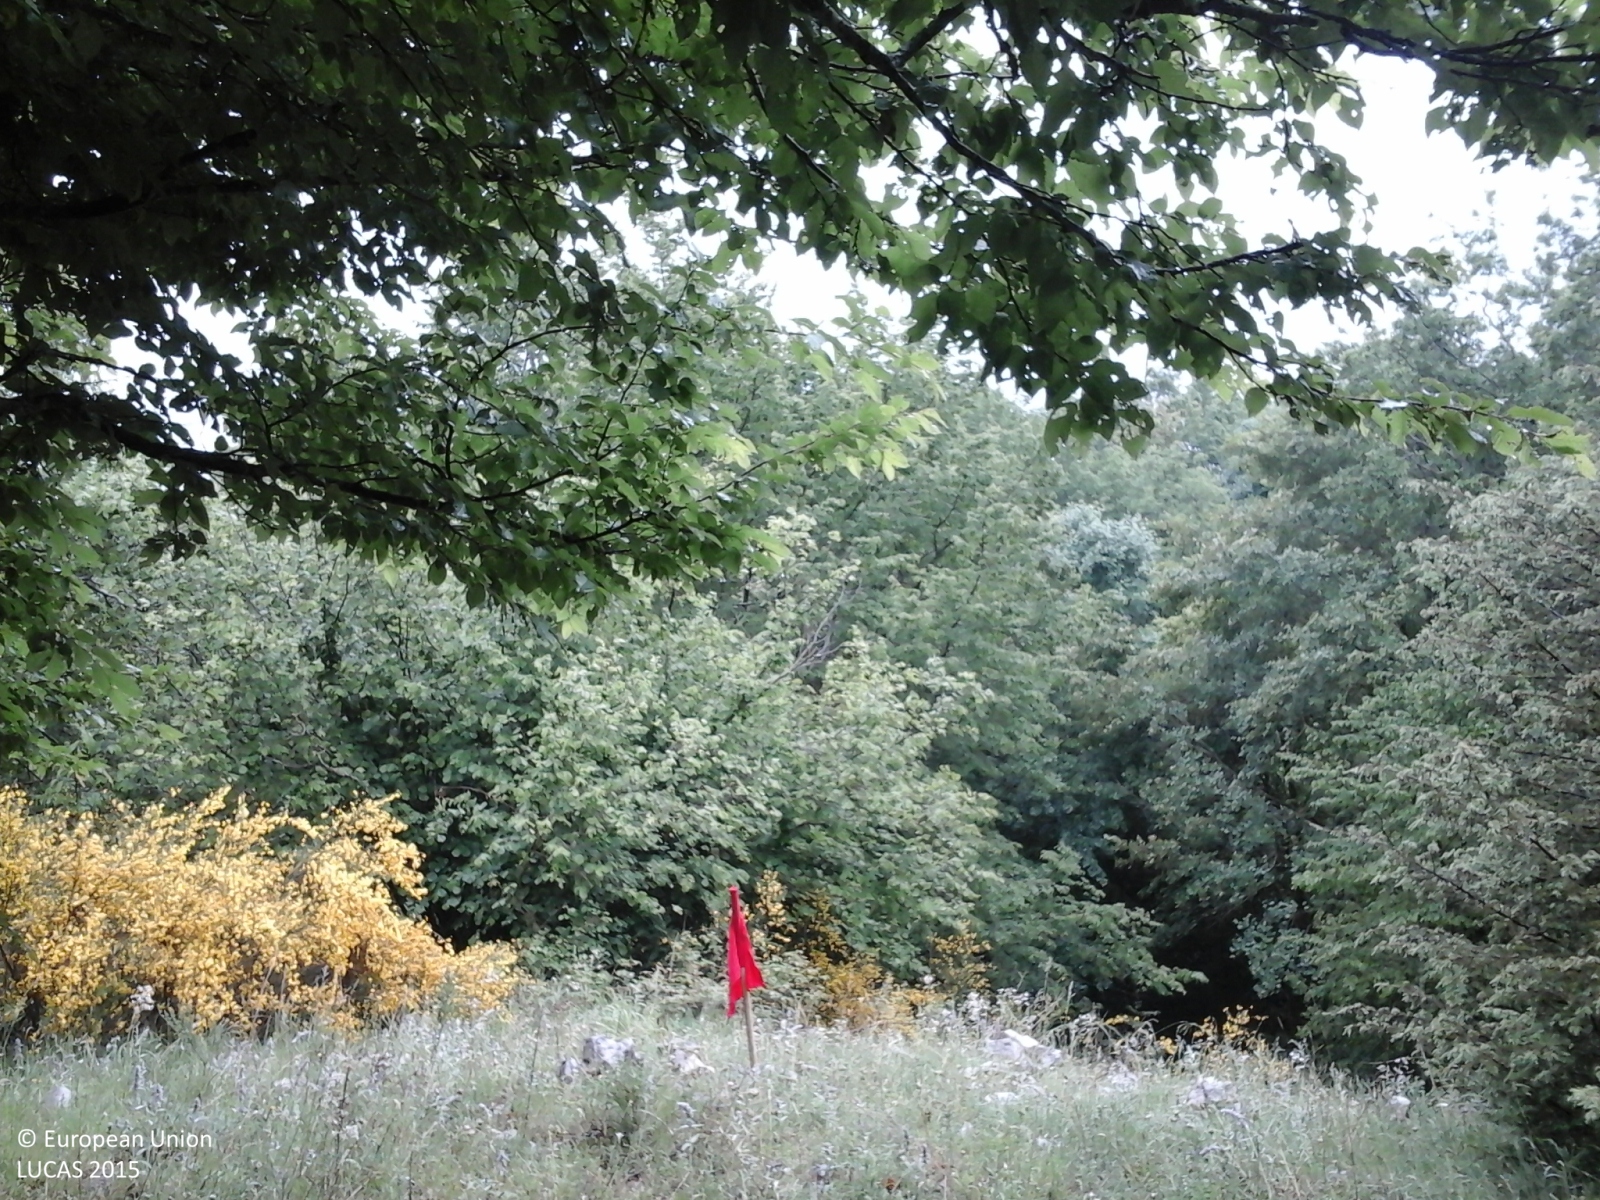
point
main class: Woodland
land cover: Broadleaved woodland
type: thermophilous deciduous forest
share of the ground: 50 - 75 %
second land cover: Grassland without tree/shrub cover
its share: 50 - 75 %
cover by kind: broadleaved forest trees 90 %, shrubs 5 %, herbaceous plants 5 %
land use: Forestry
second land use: Agriculture (excluding fallow land and kitchen gardens)
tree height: > 5 m
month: May
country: IT
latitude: 41.8267
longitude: 13.1790
